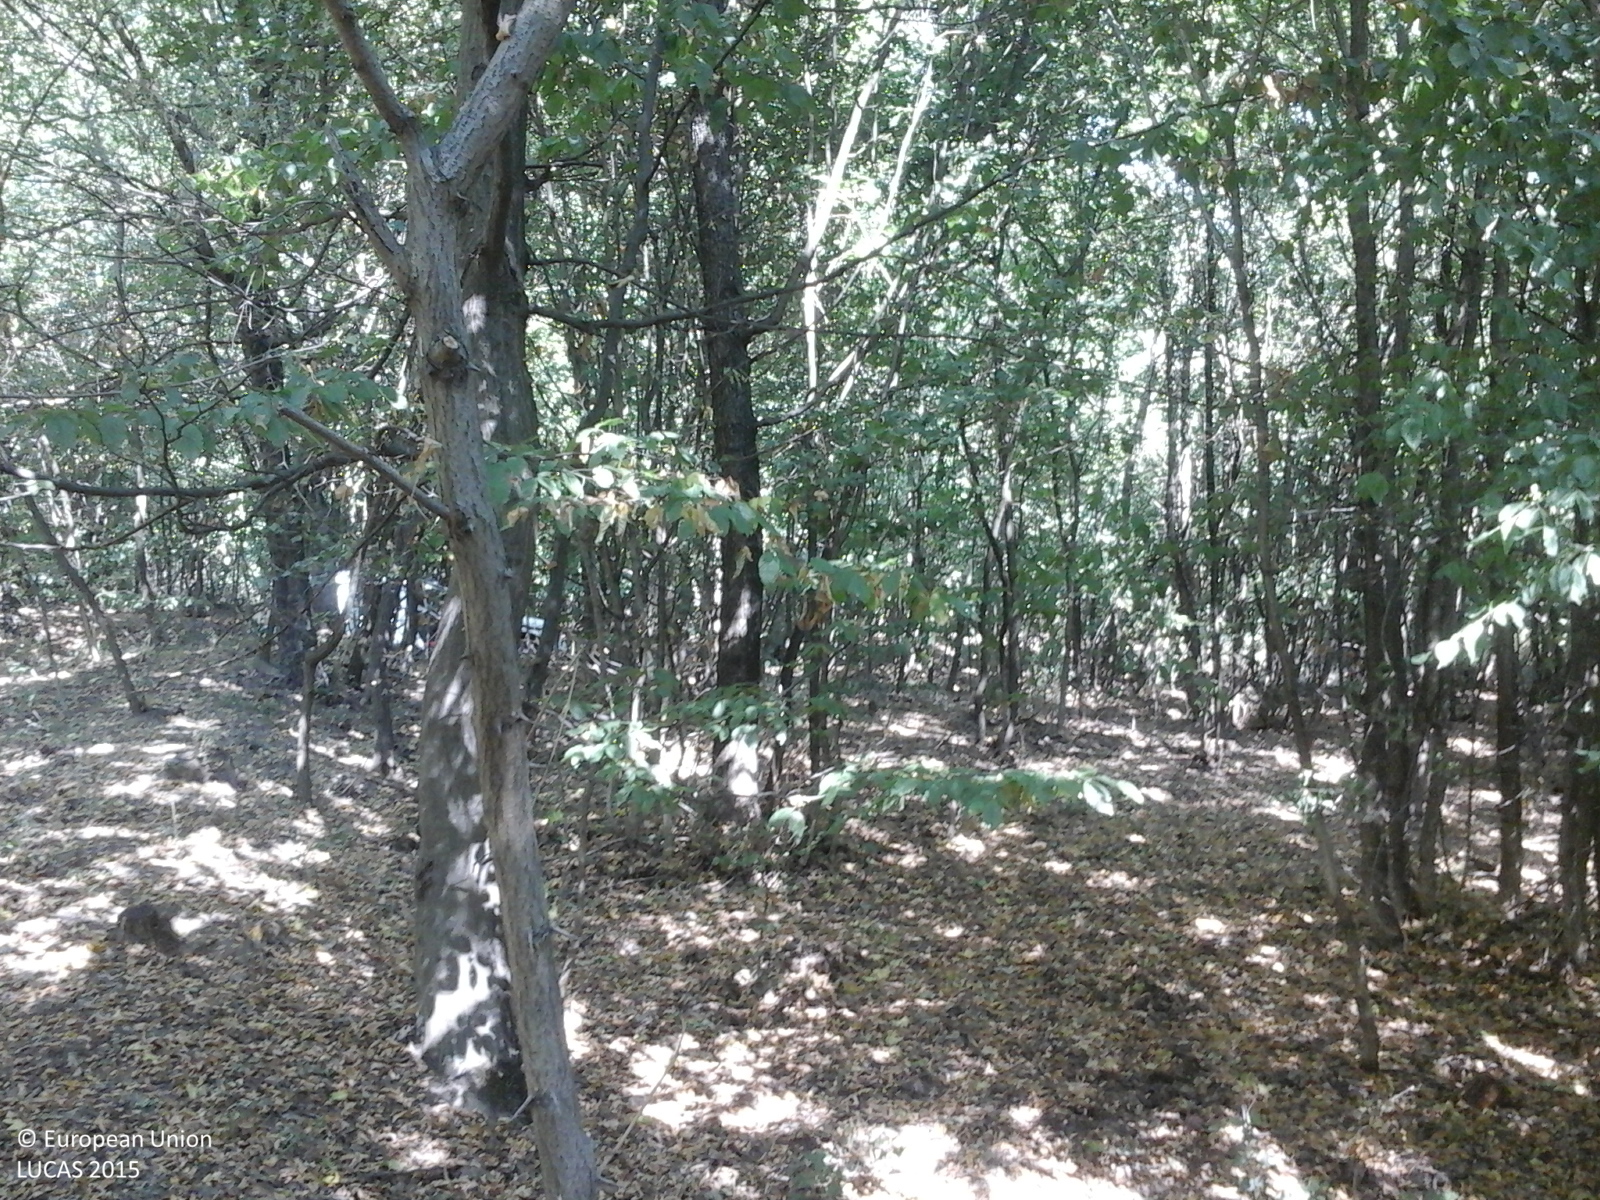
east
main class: Woodland
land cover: Broadleaved woodland
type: exotic forest
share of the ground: > 75 %
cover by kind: broadleaved forest trees 100 %
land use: Forestry
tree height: > 5 m
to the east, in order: Broadleaved woodland; Tracks; Broadleaved woodland
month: July
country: RO
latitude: 46.3026
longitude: 27.3331
